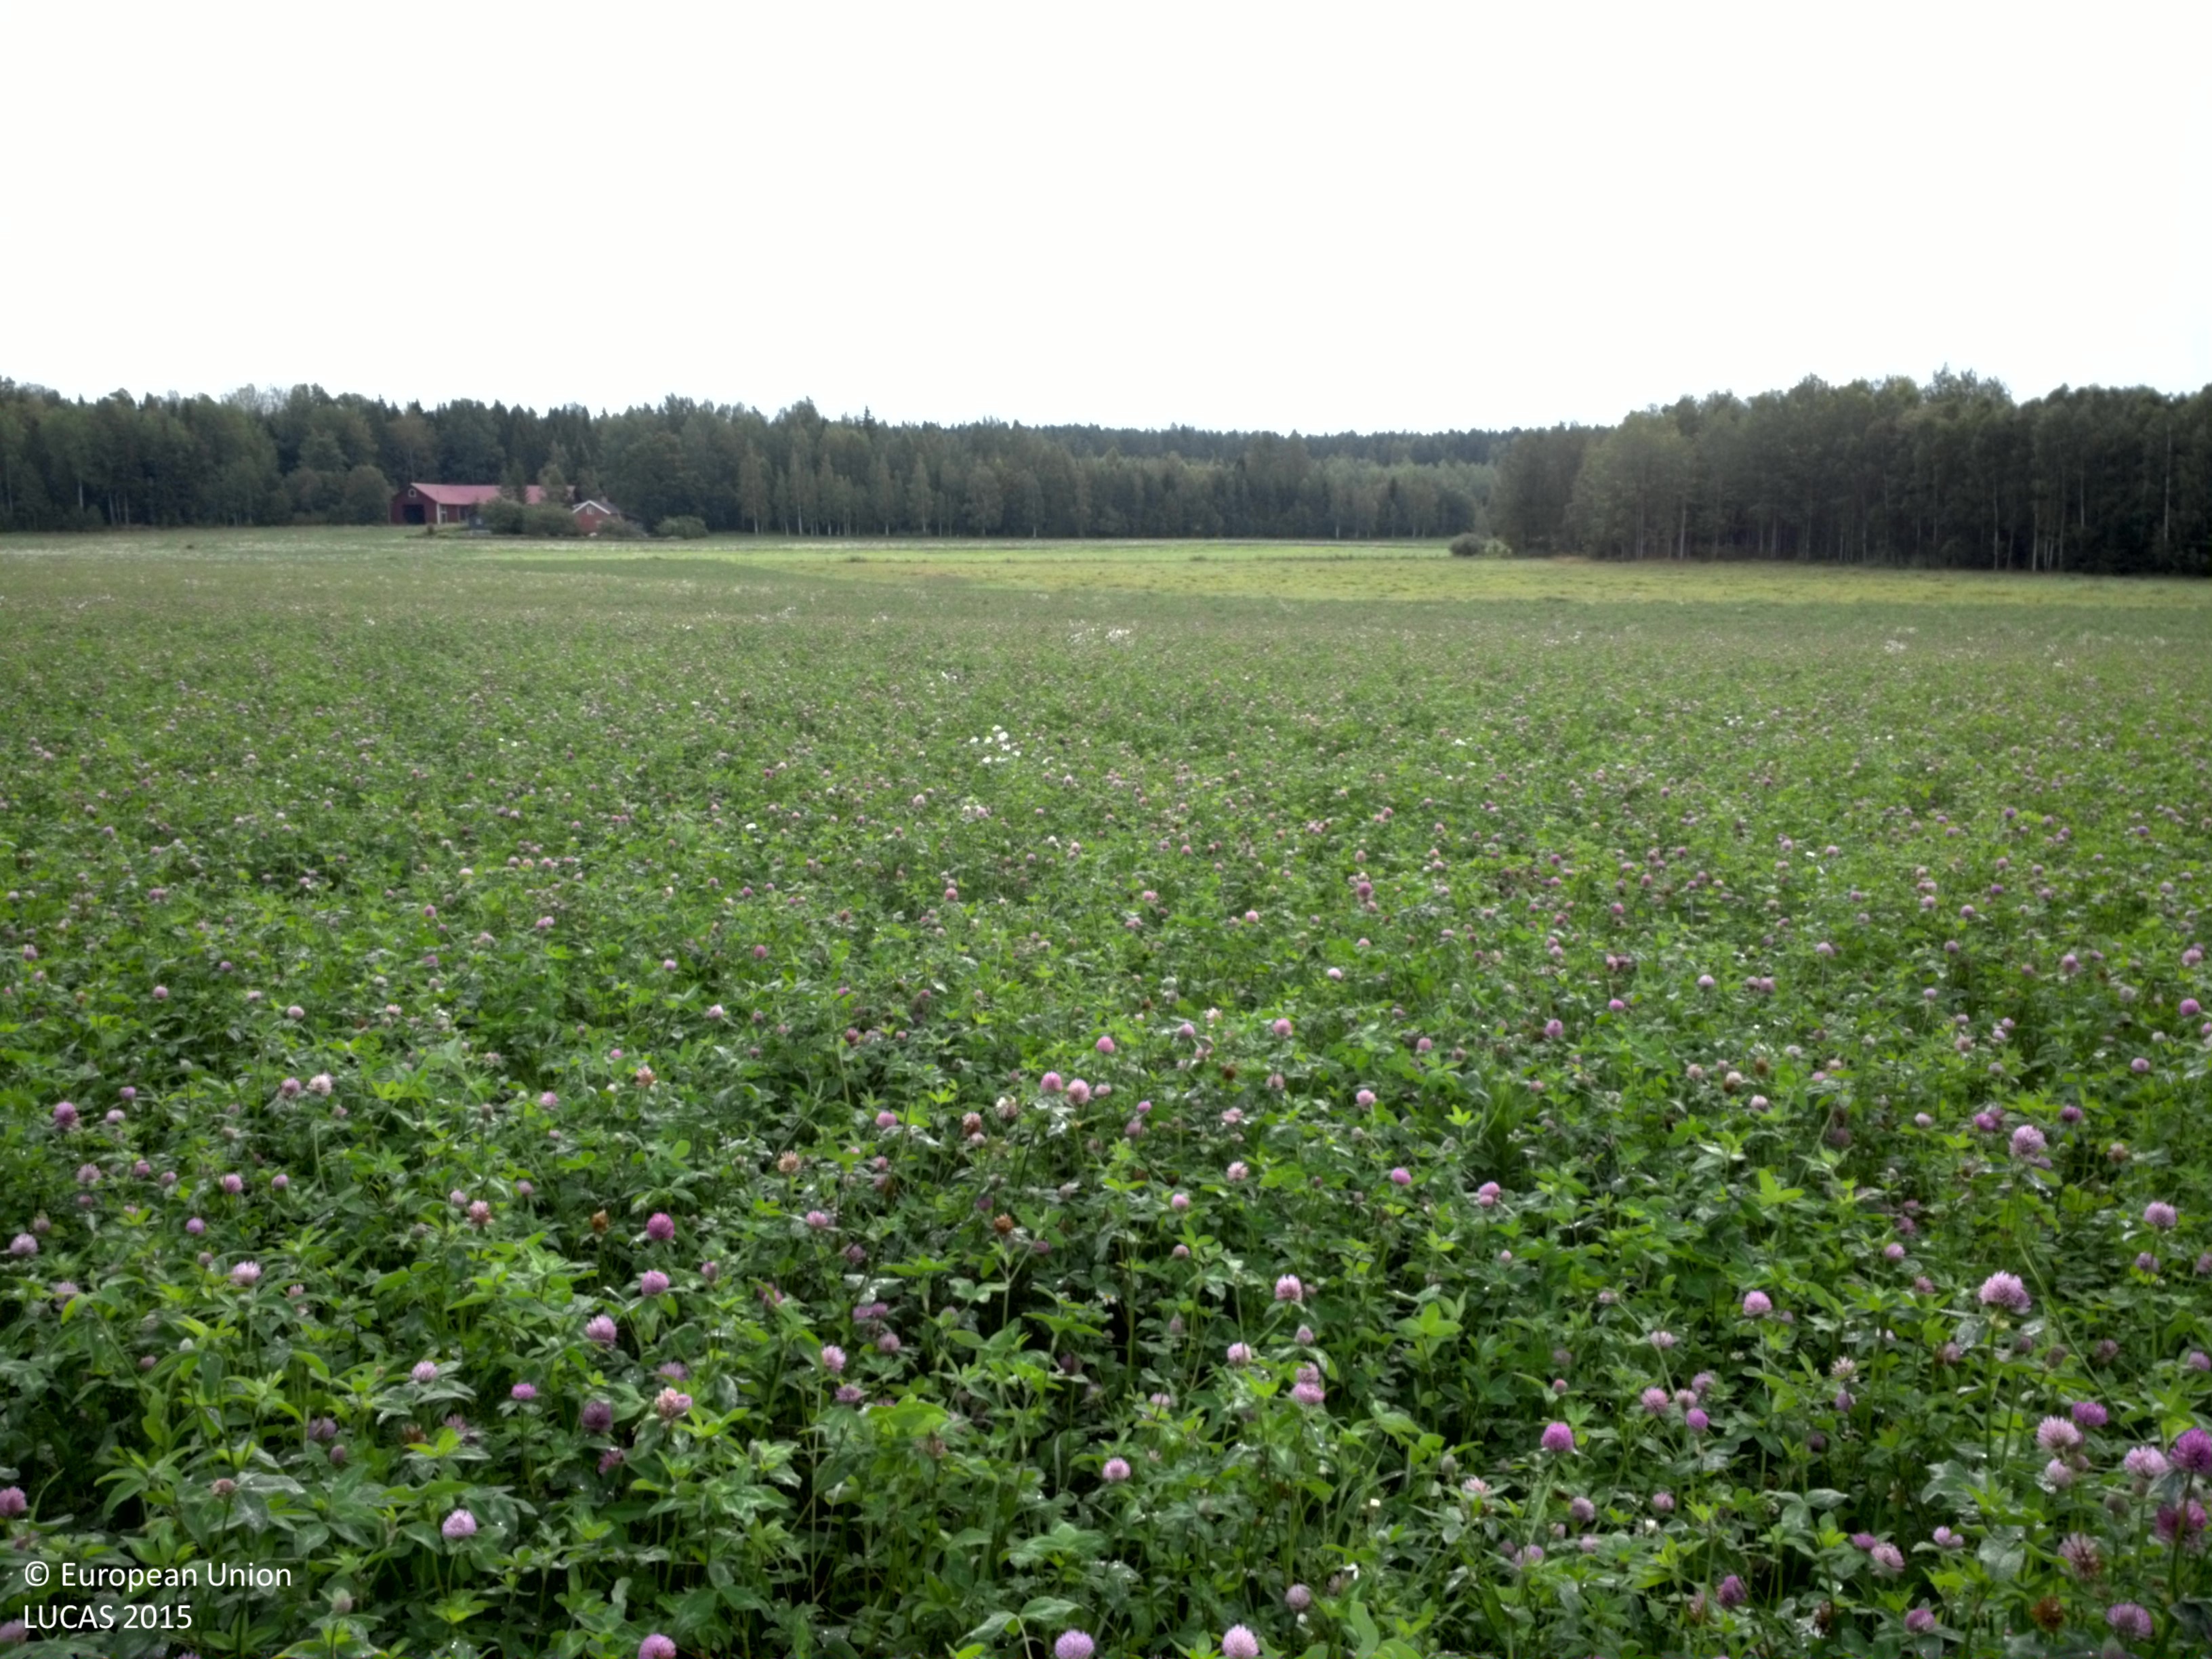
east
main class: Cropland
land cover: Clovers
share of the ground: > 75 %
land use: Agriculture (excluding fallow land and kitchen gardens)
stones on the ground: < 10 %
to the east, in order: Clovers; Temporary grasslands
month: August
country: SE
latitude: 59.9264
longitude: 16.4134
